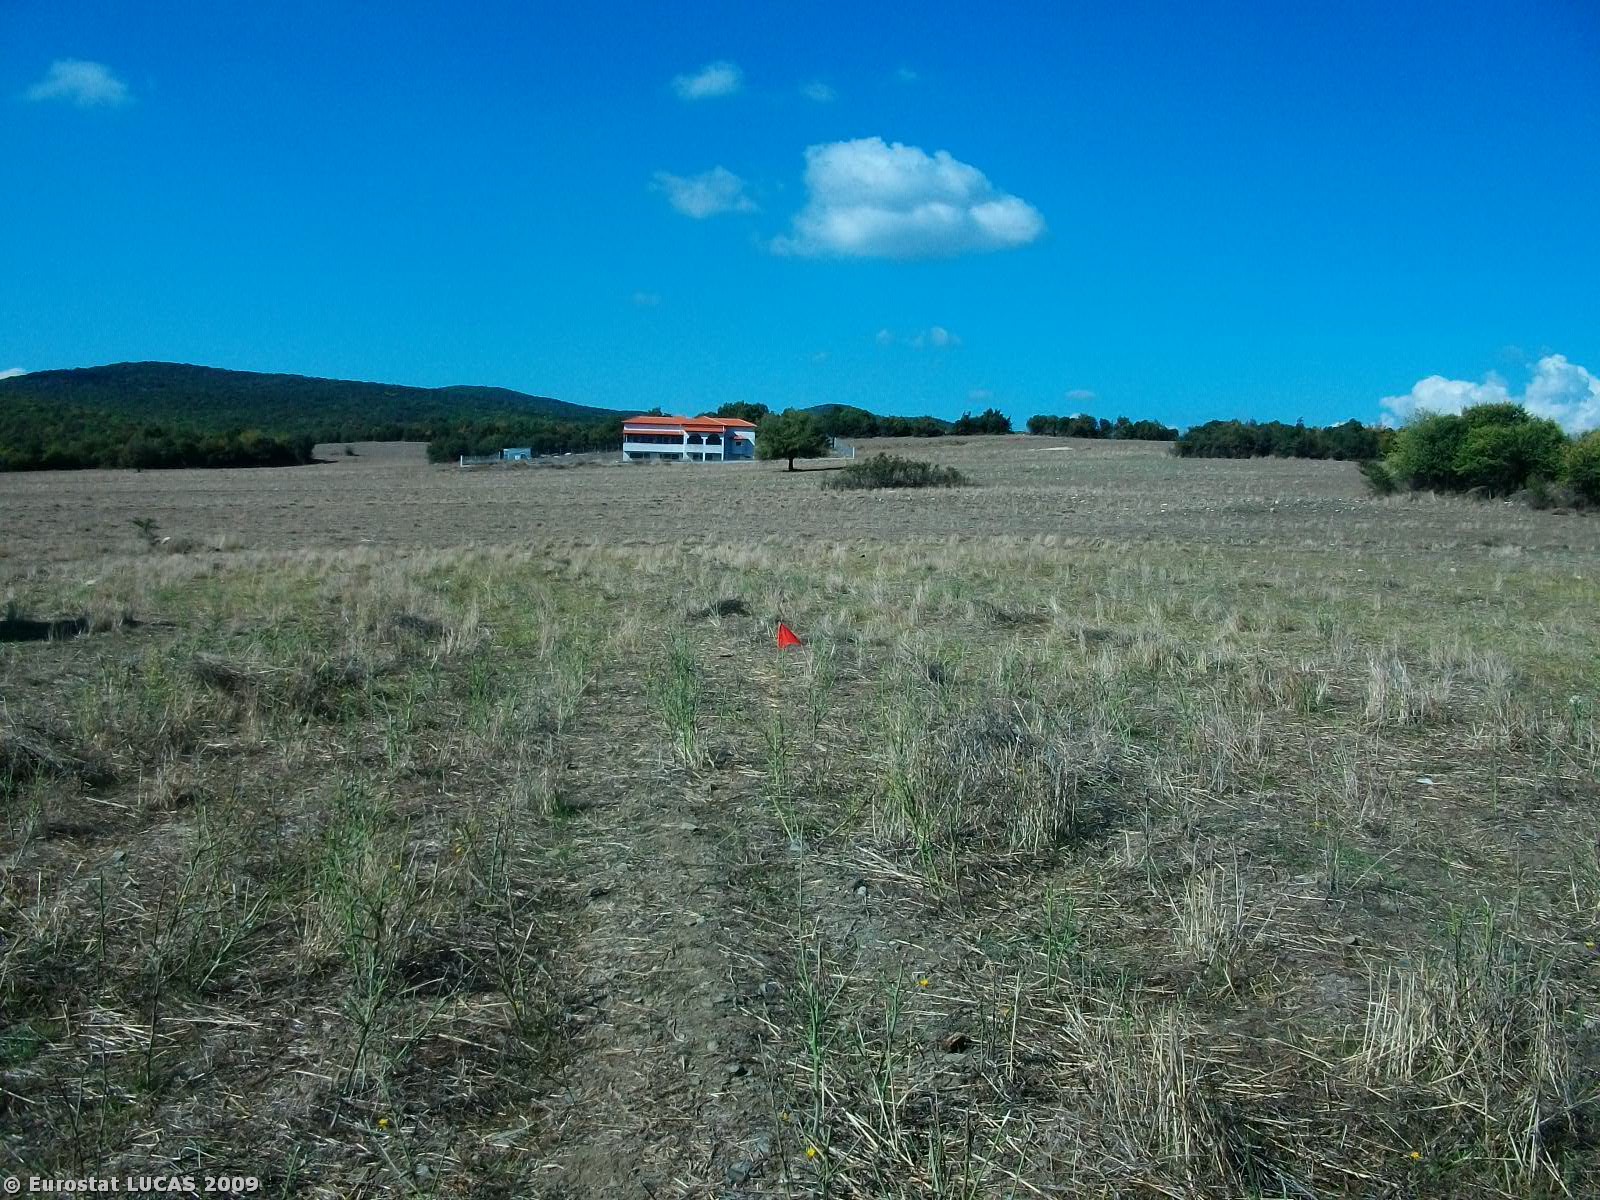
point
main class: Grassland
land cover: Spontaneously vegetated surfaces
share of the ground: > 75 %
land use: Fallow land
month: October
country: GR
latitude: 40.7293
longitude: 23.5731
